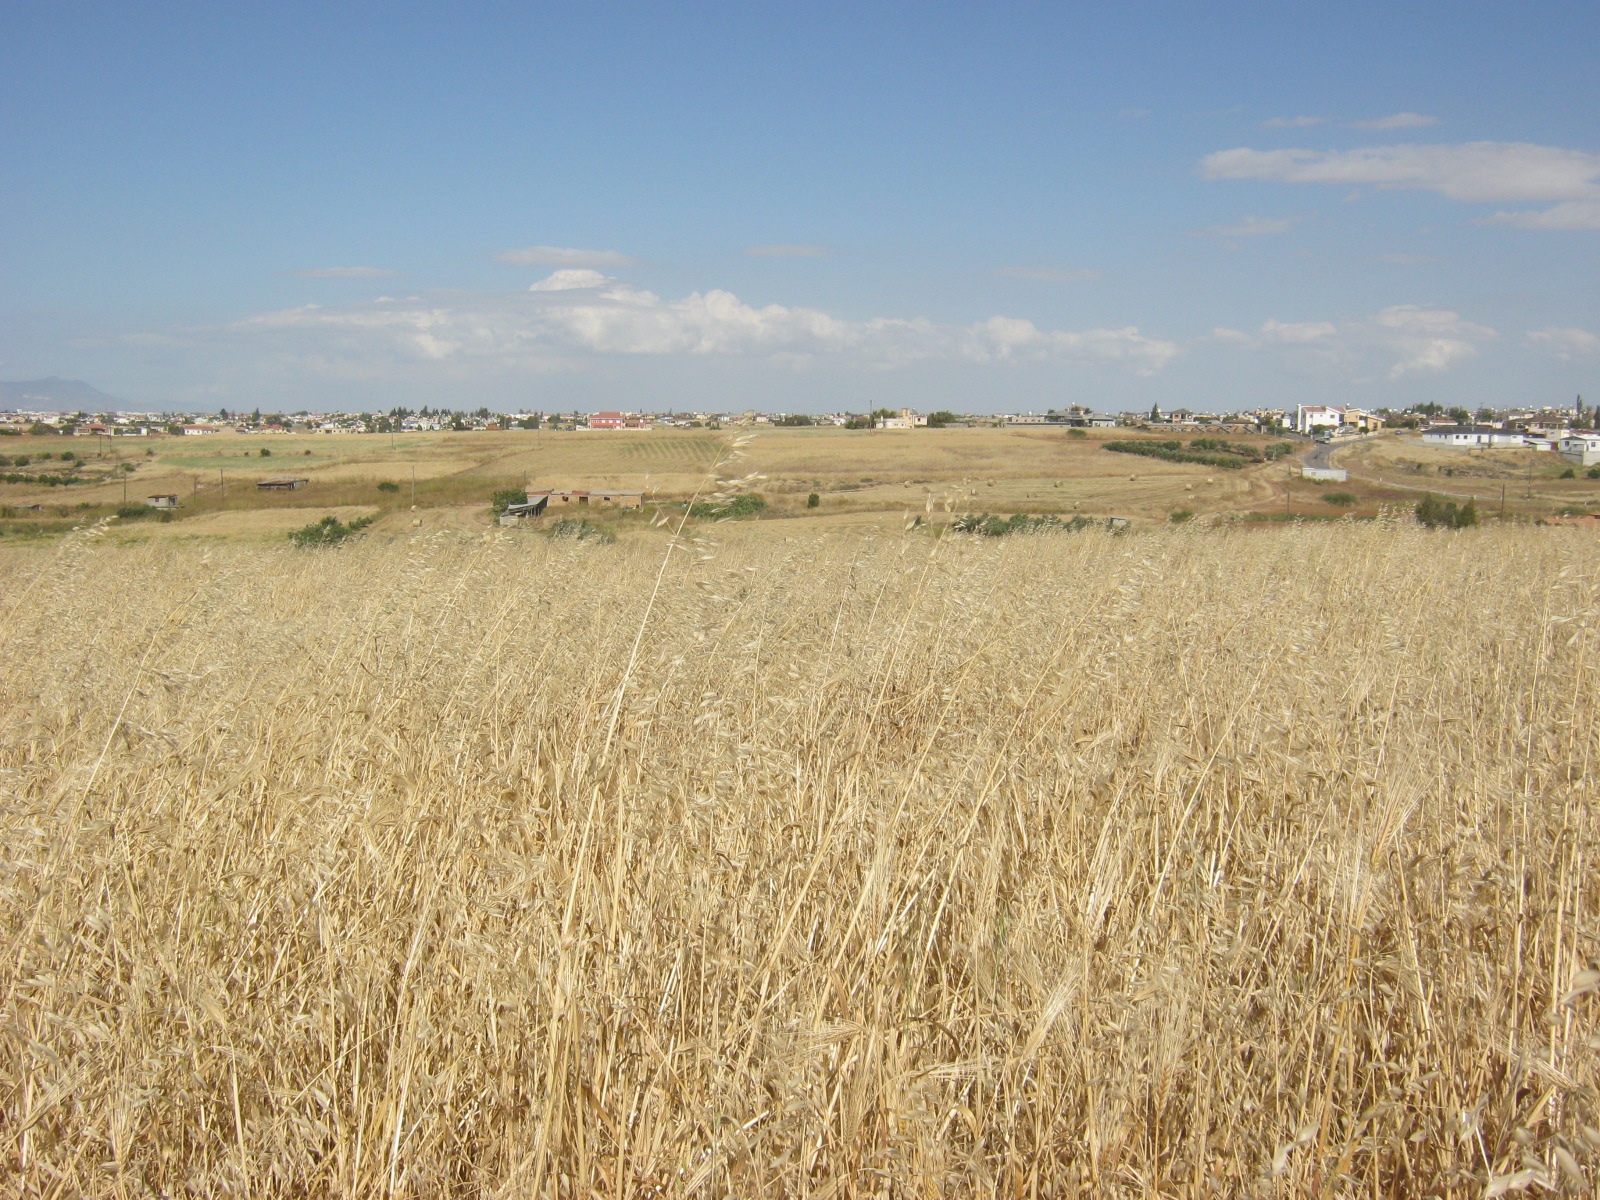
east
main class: Cropland
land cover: Barley
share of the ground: > 75 %
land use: Agriculture (excluding fallow land and kitchen gardens)
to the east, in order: Barley; Grassland without tree/shrub cover; Barley; Single bushes/trees; Grass margins; Barley; Mixed cereals for fodder
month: May
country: CY
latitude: 35.1244
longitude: 33.1742
